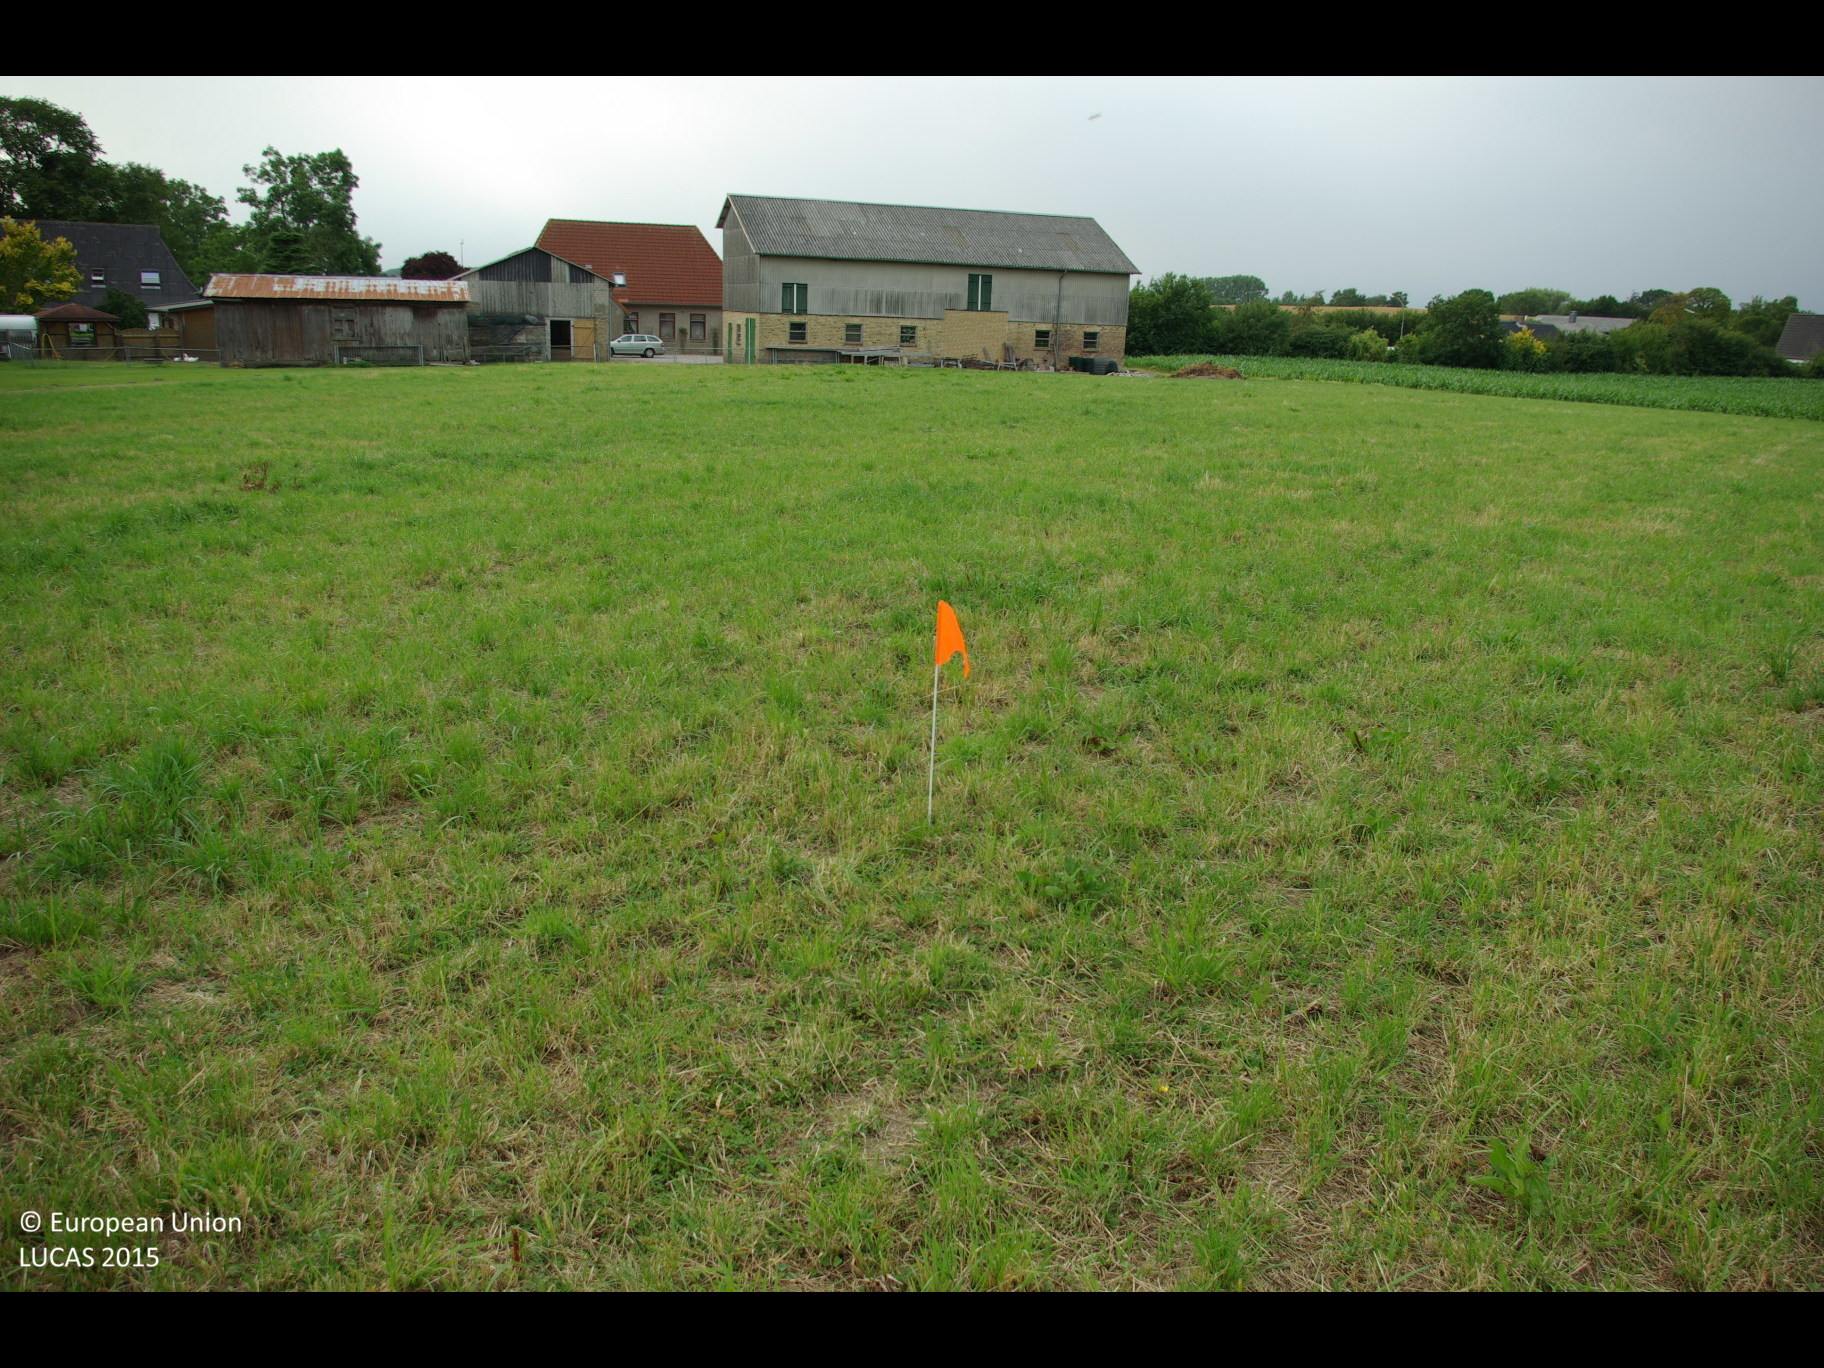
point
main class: Cropland
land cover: Temporary grasslands
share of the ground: > 75 %
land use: Agriculture (excluding fallow land and kitchen gardens)
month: July
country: DE
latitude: 54.6420
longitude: 9.9535
